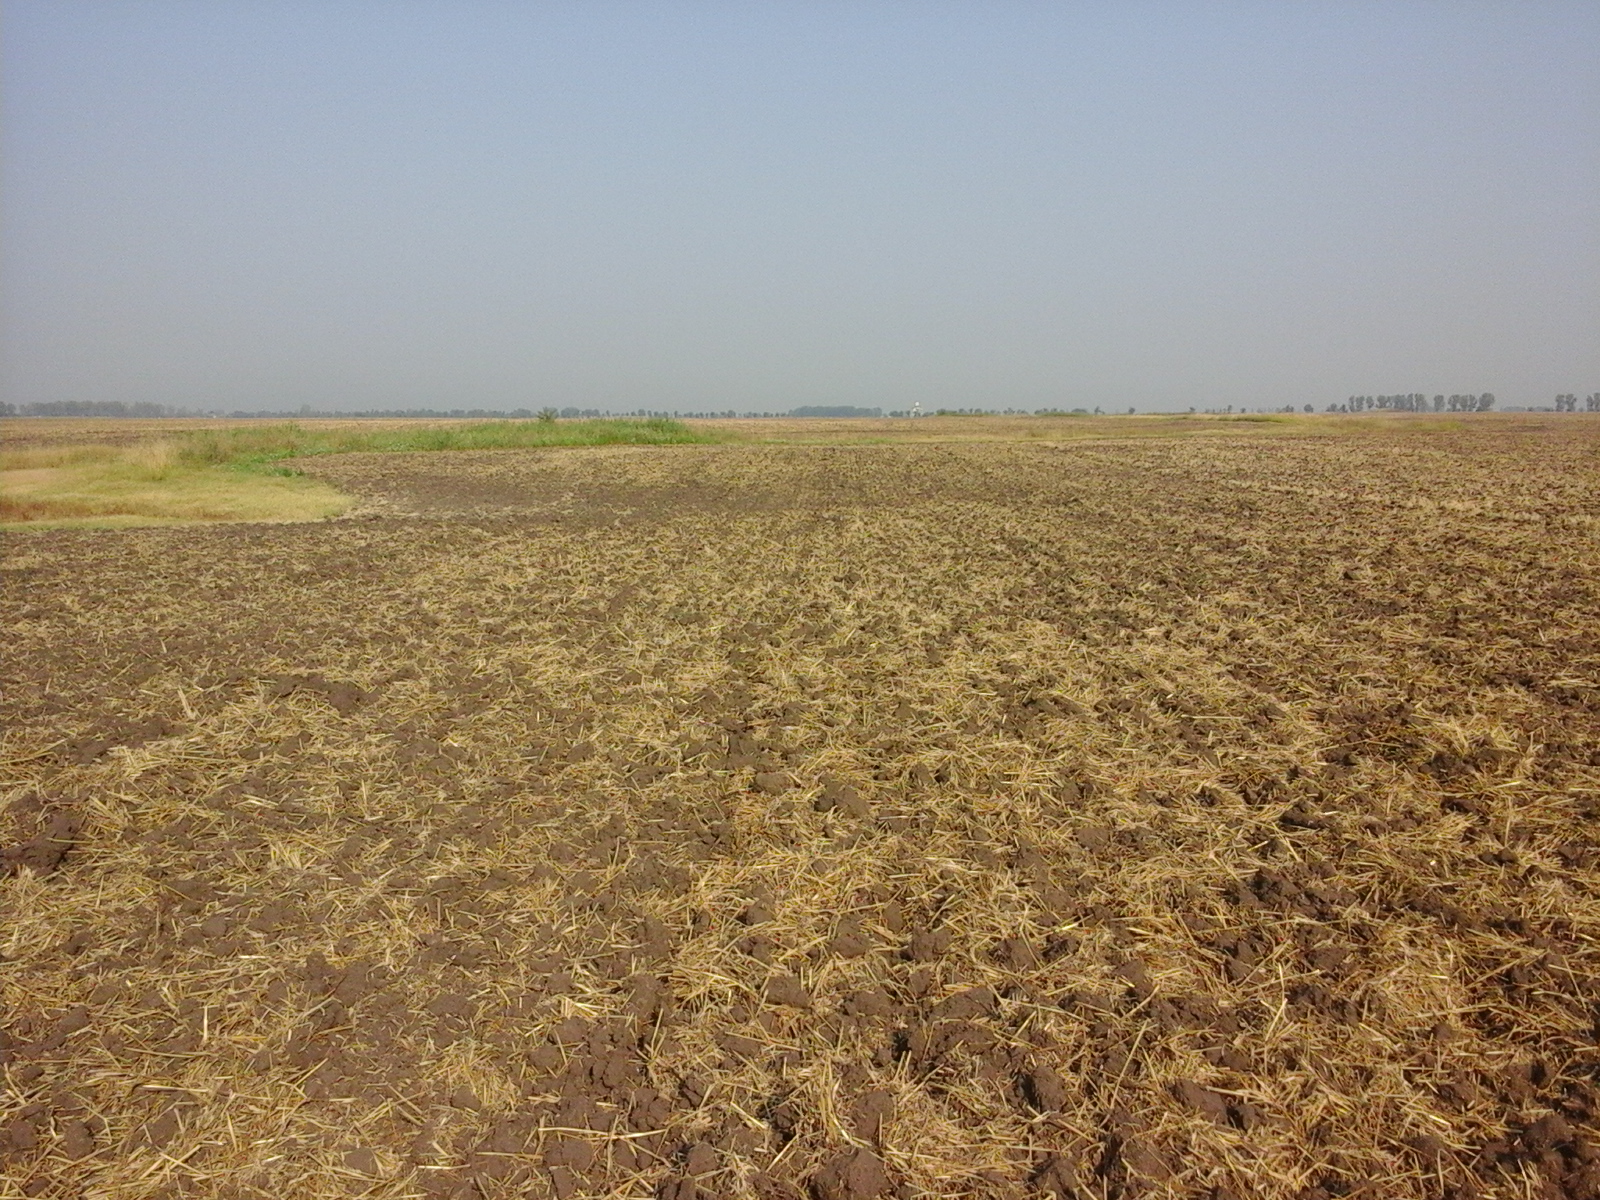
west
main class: Cropland
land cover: Common wheat
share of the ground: 50 - 75 %
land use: Agriculture (excluding fallow land and kitchen gardens)
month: August
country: RO
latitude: 44.0140
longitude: 23.4832
